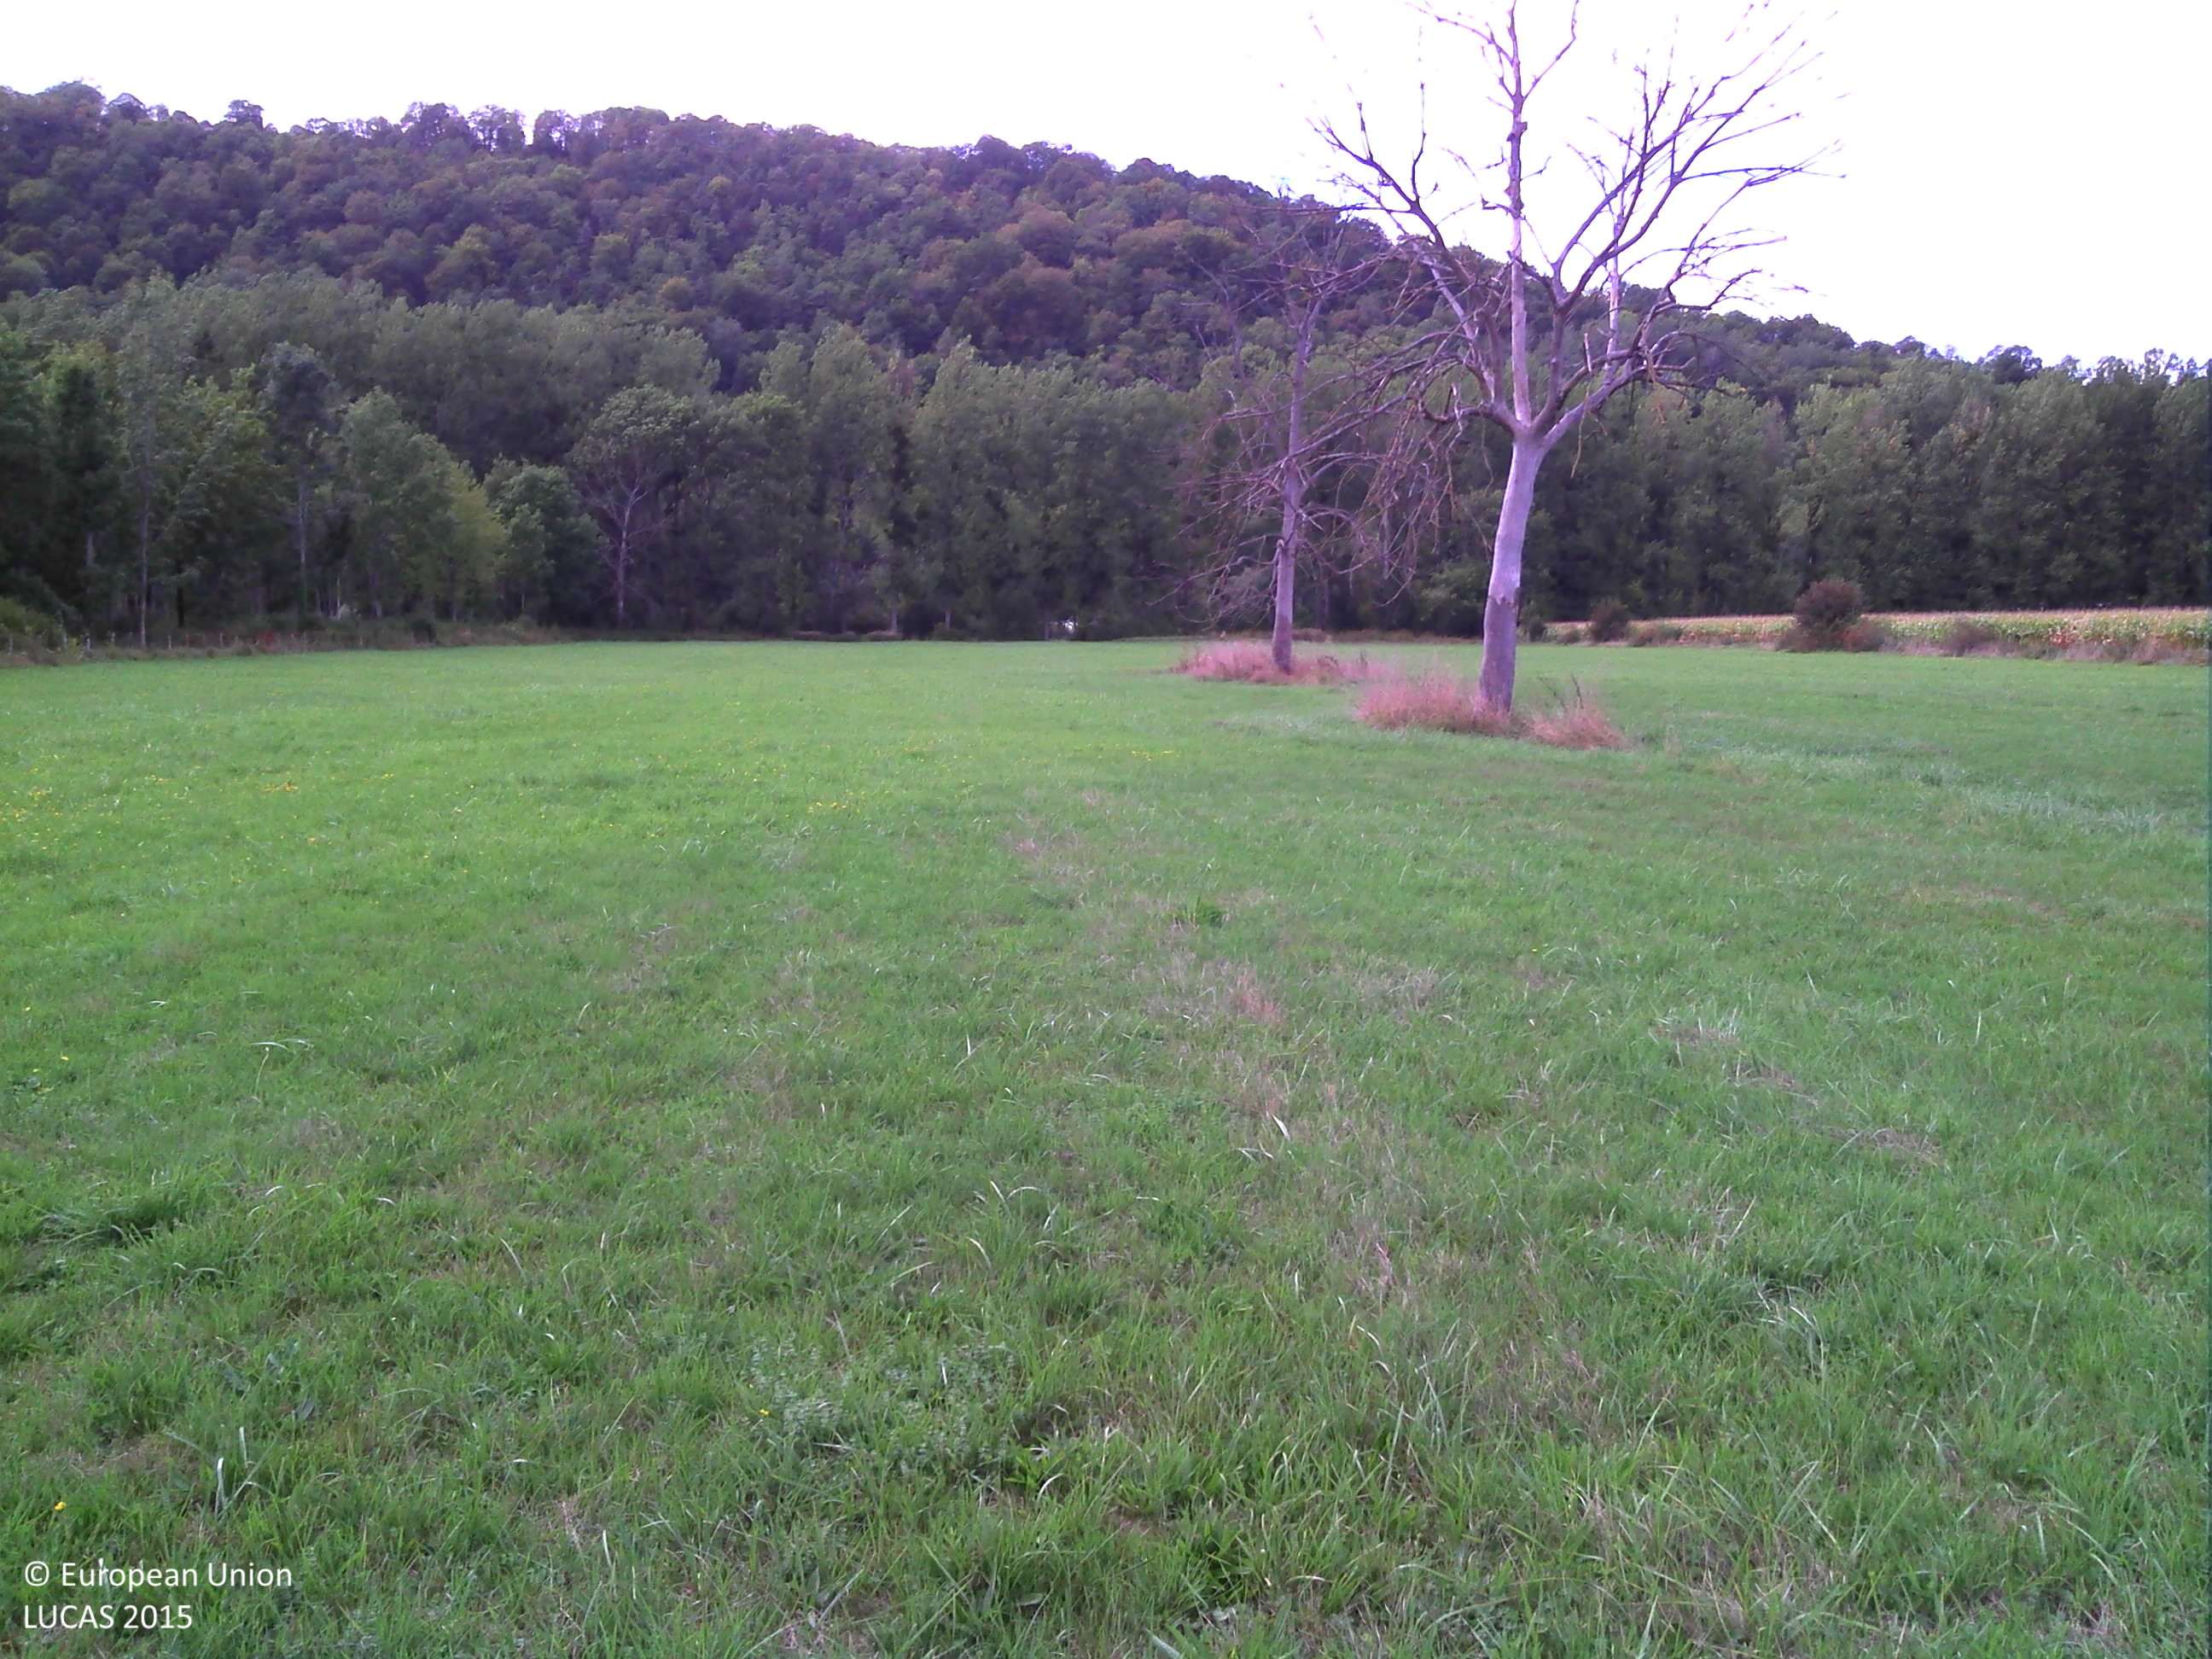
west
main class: Grassland
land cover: Grassland without tree/shrub cover
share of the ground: > 75 %
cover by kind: herbaceous plants 100 %
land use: Agriculture (excluding fallow land and kitchen gardens)
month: September
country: FR
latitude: 48.2227
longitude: 4.7082
